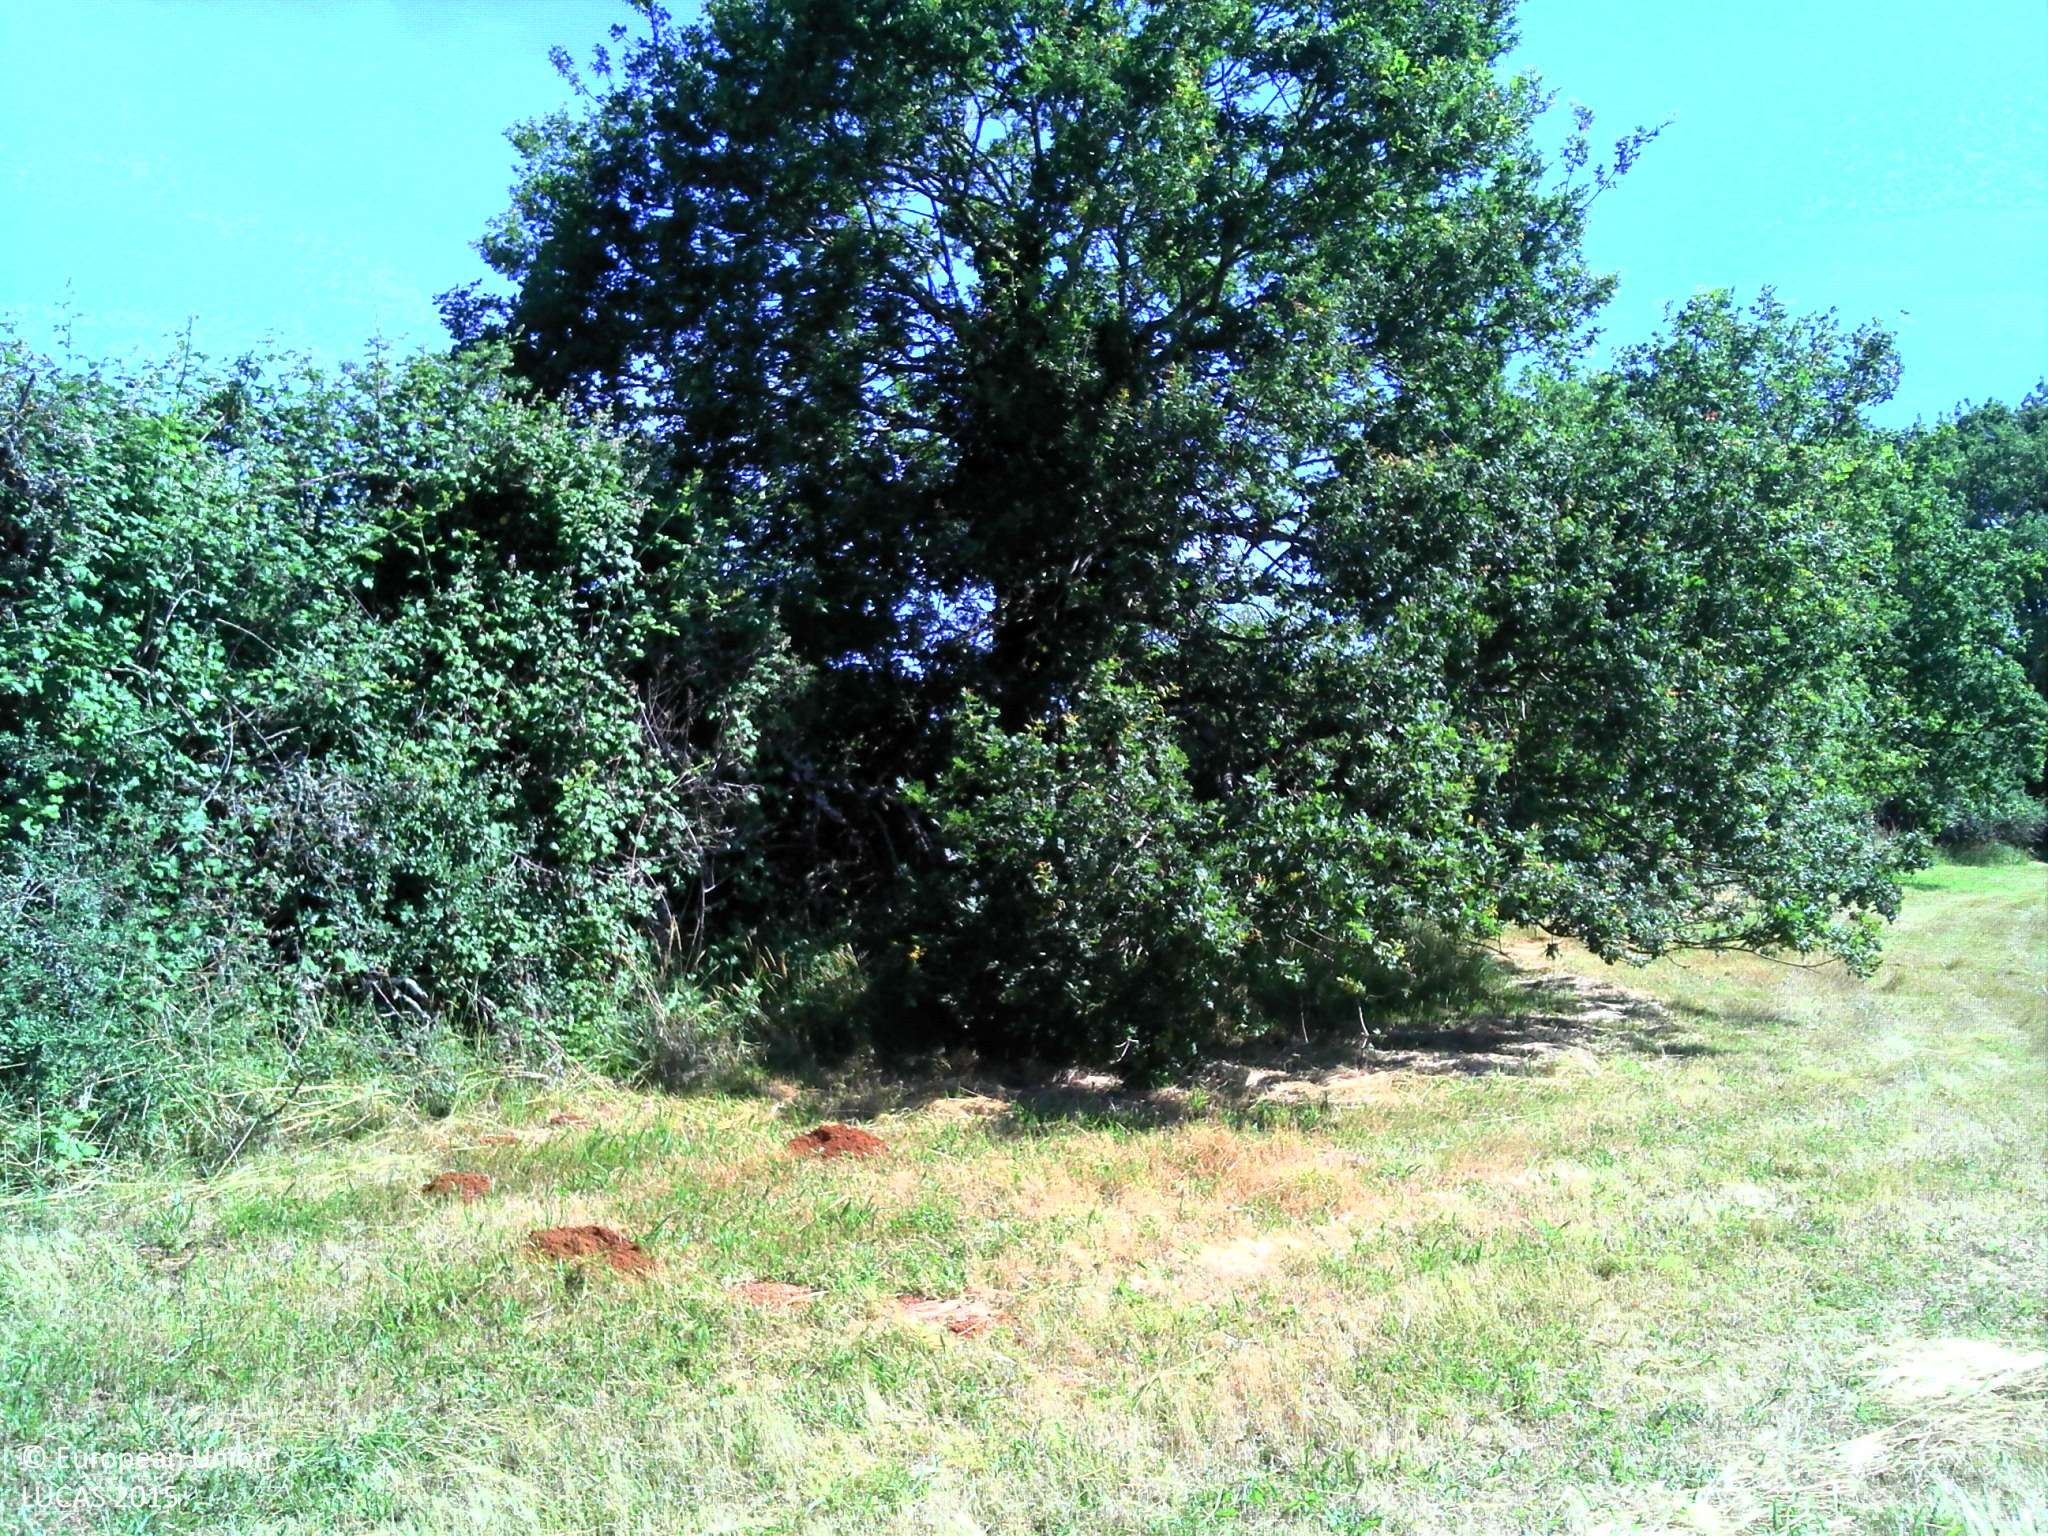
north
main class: Grassland
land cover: Grassland without tree/shrub cover
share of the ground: > 75 %
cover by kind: herbaceous plants 100 %
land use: Agriculture (excluding fallow land and kitchen gardens)
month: June
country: FR
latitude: 44.7504
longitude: 1.8009
